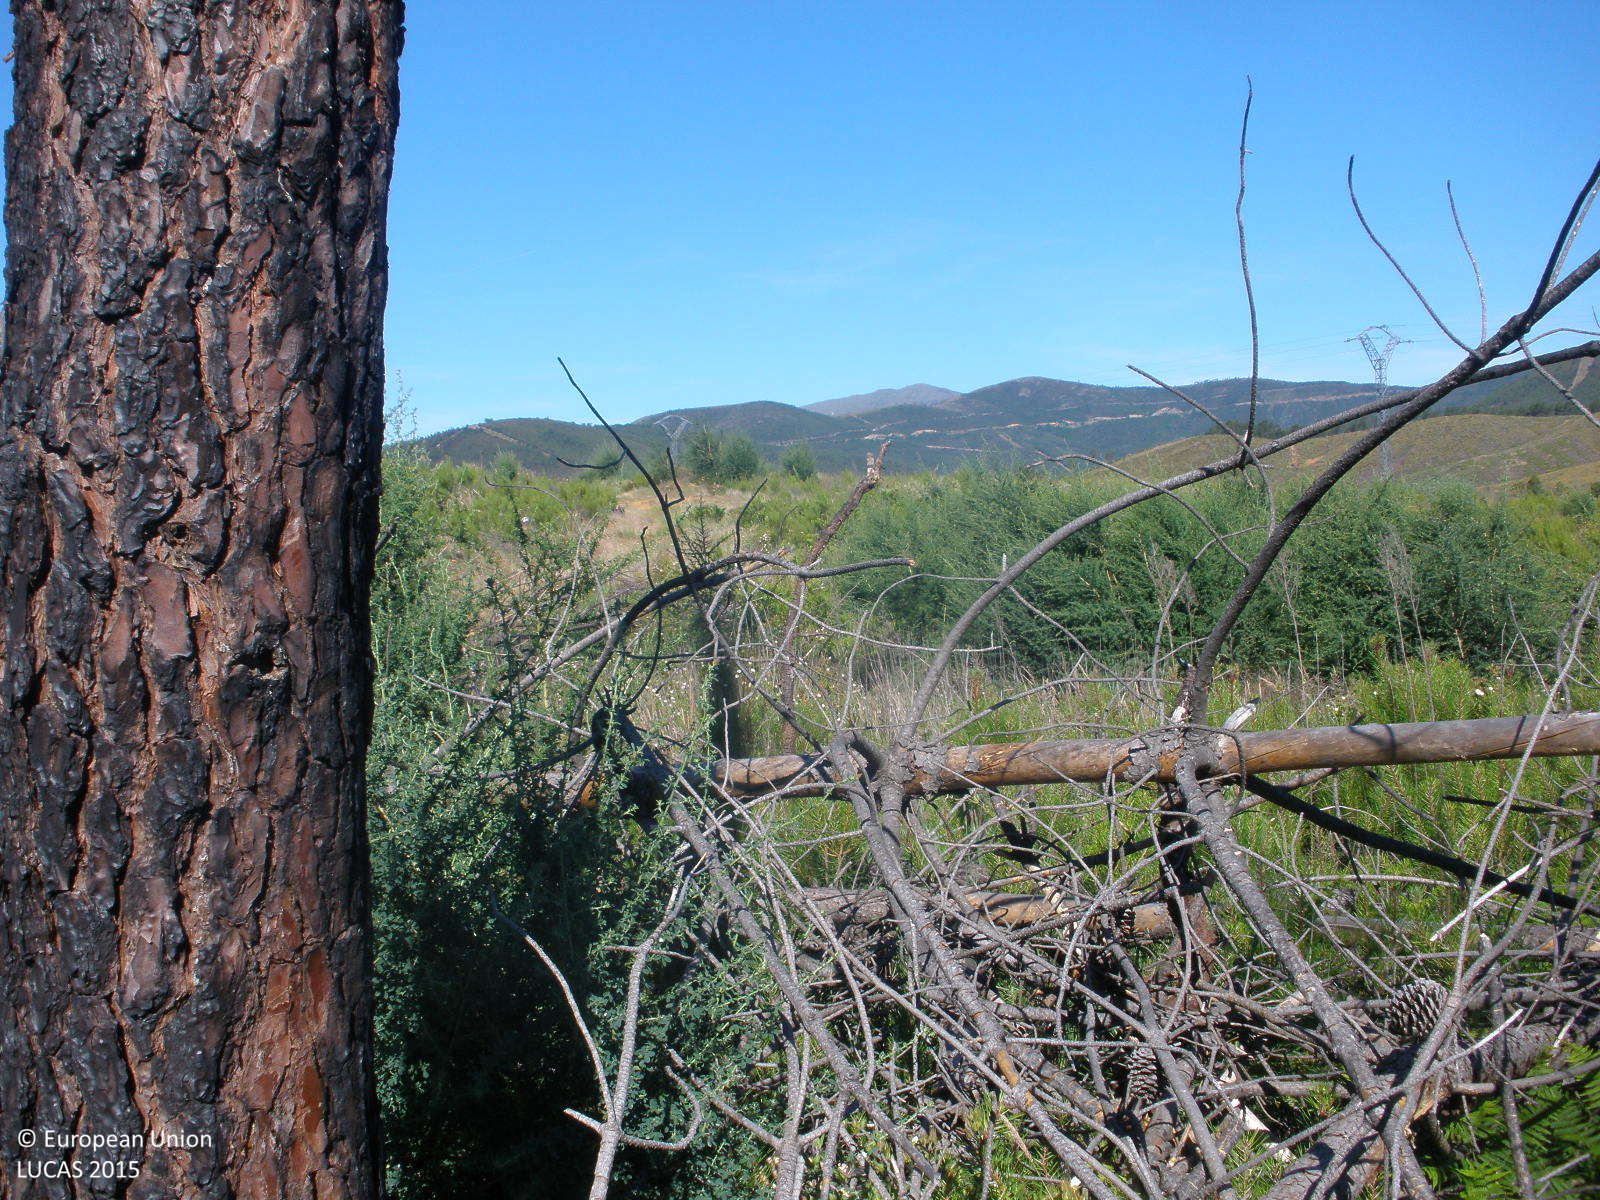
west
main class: Shrubland
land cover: Shrubland without tree cover
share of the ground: > 75 %
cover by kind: shrubs 80 %, herbaceous plants 20 %
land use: Forestry
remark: Burnt area
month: May
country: ES
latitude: 40.2204
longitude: -6.6195
